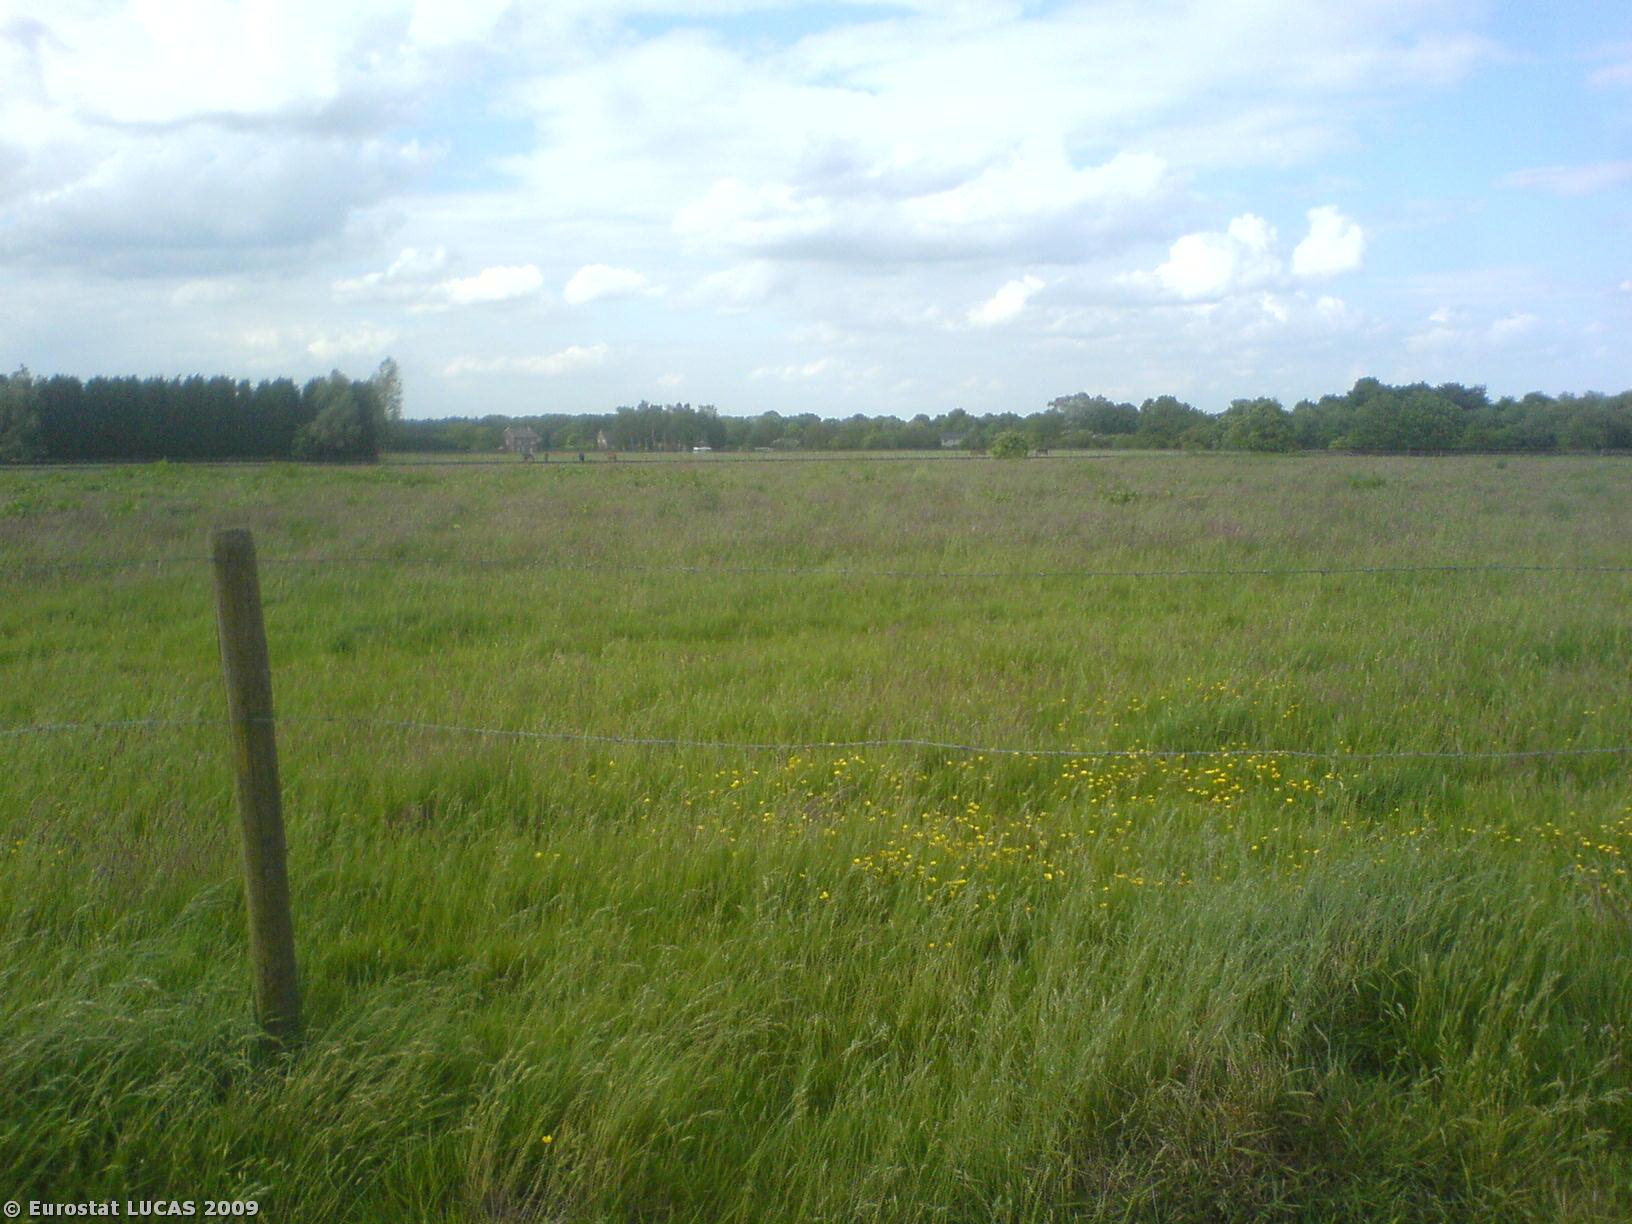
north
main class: Artificial land
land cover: Non built-up linear features
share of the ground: 10 - 25 %
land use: Road transport
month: May
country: NL
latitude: 51.4055
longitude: 5.3833
